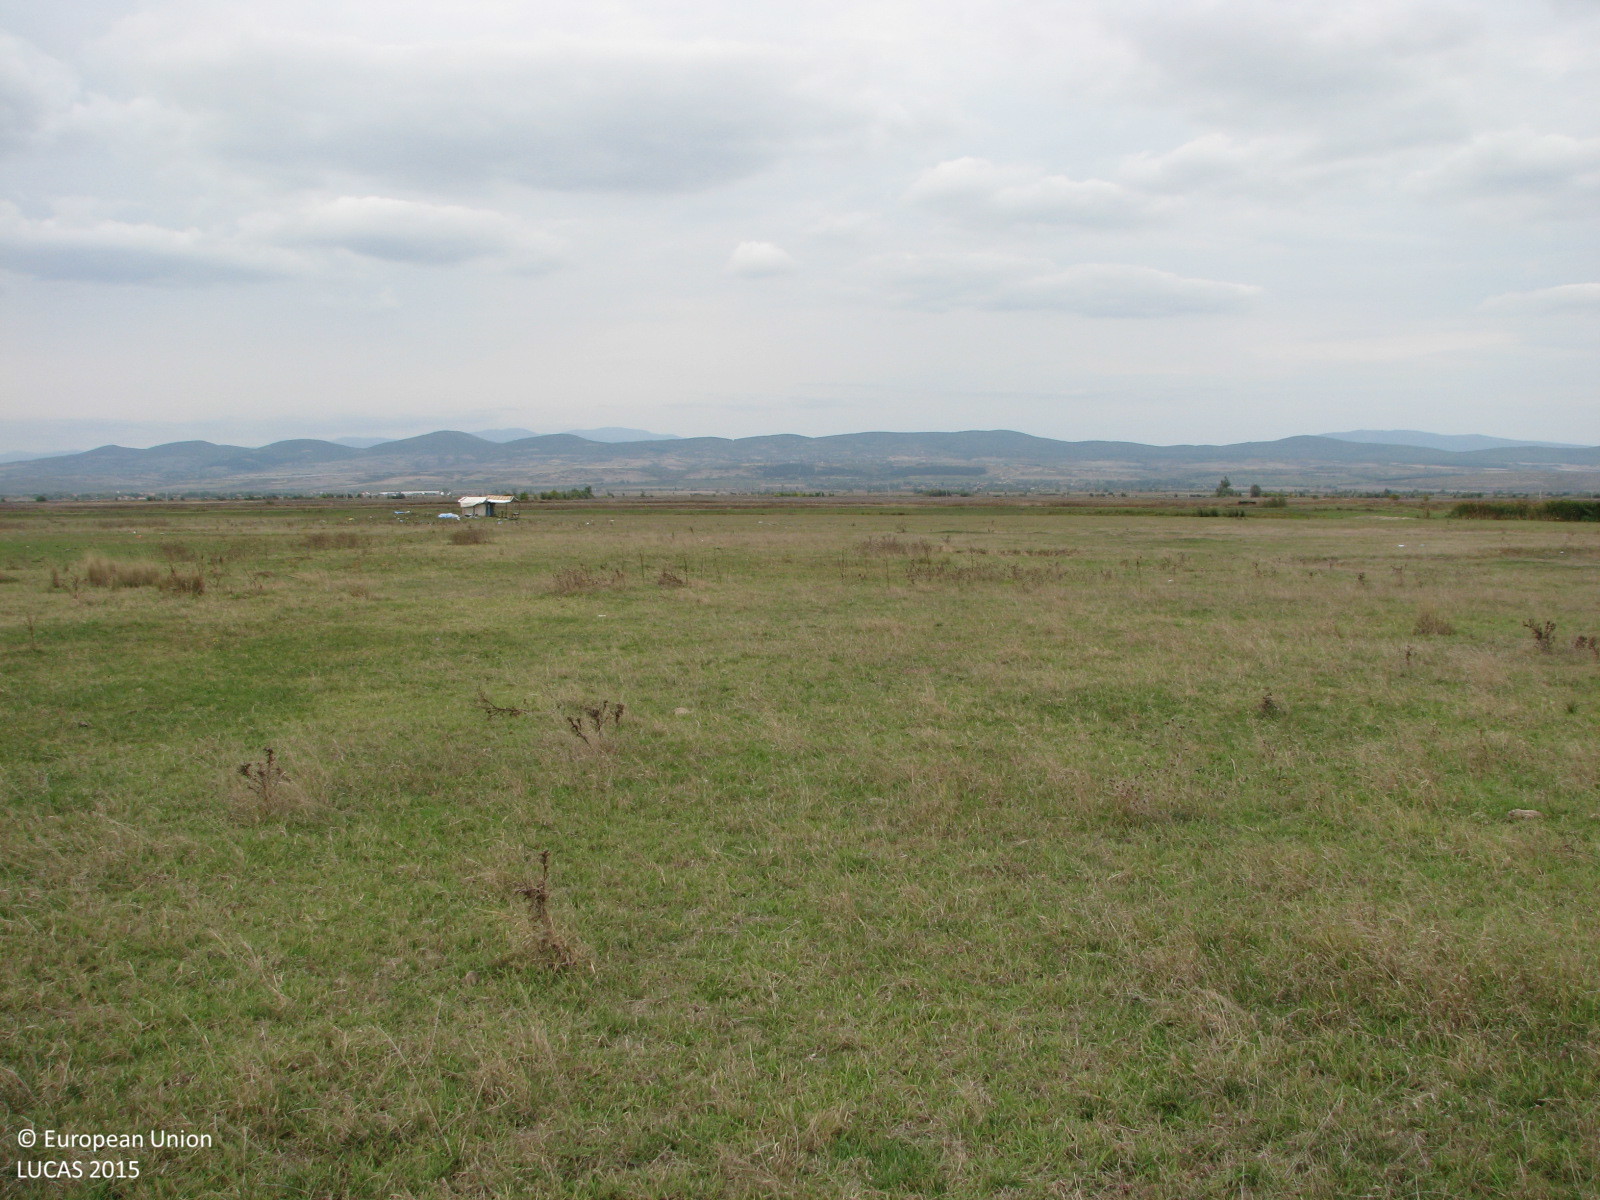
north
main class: Grassland
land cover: Grassland without tree/shrub cover
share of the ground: > 75 %
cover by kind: herbaceous plants 100 %
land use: Agriculture (excluding fallow land and kitchen gardens)
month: October
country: BG
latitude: 42.4943
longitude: 26.1076
